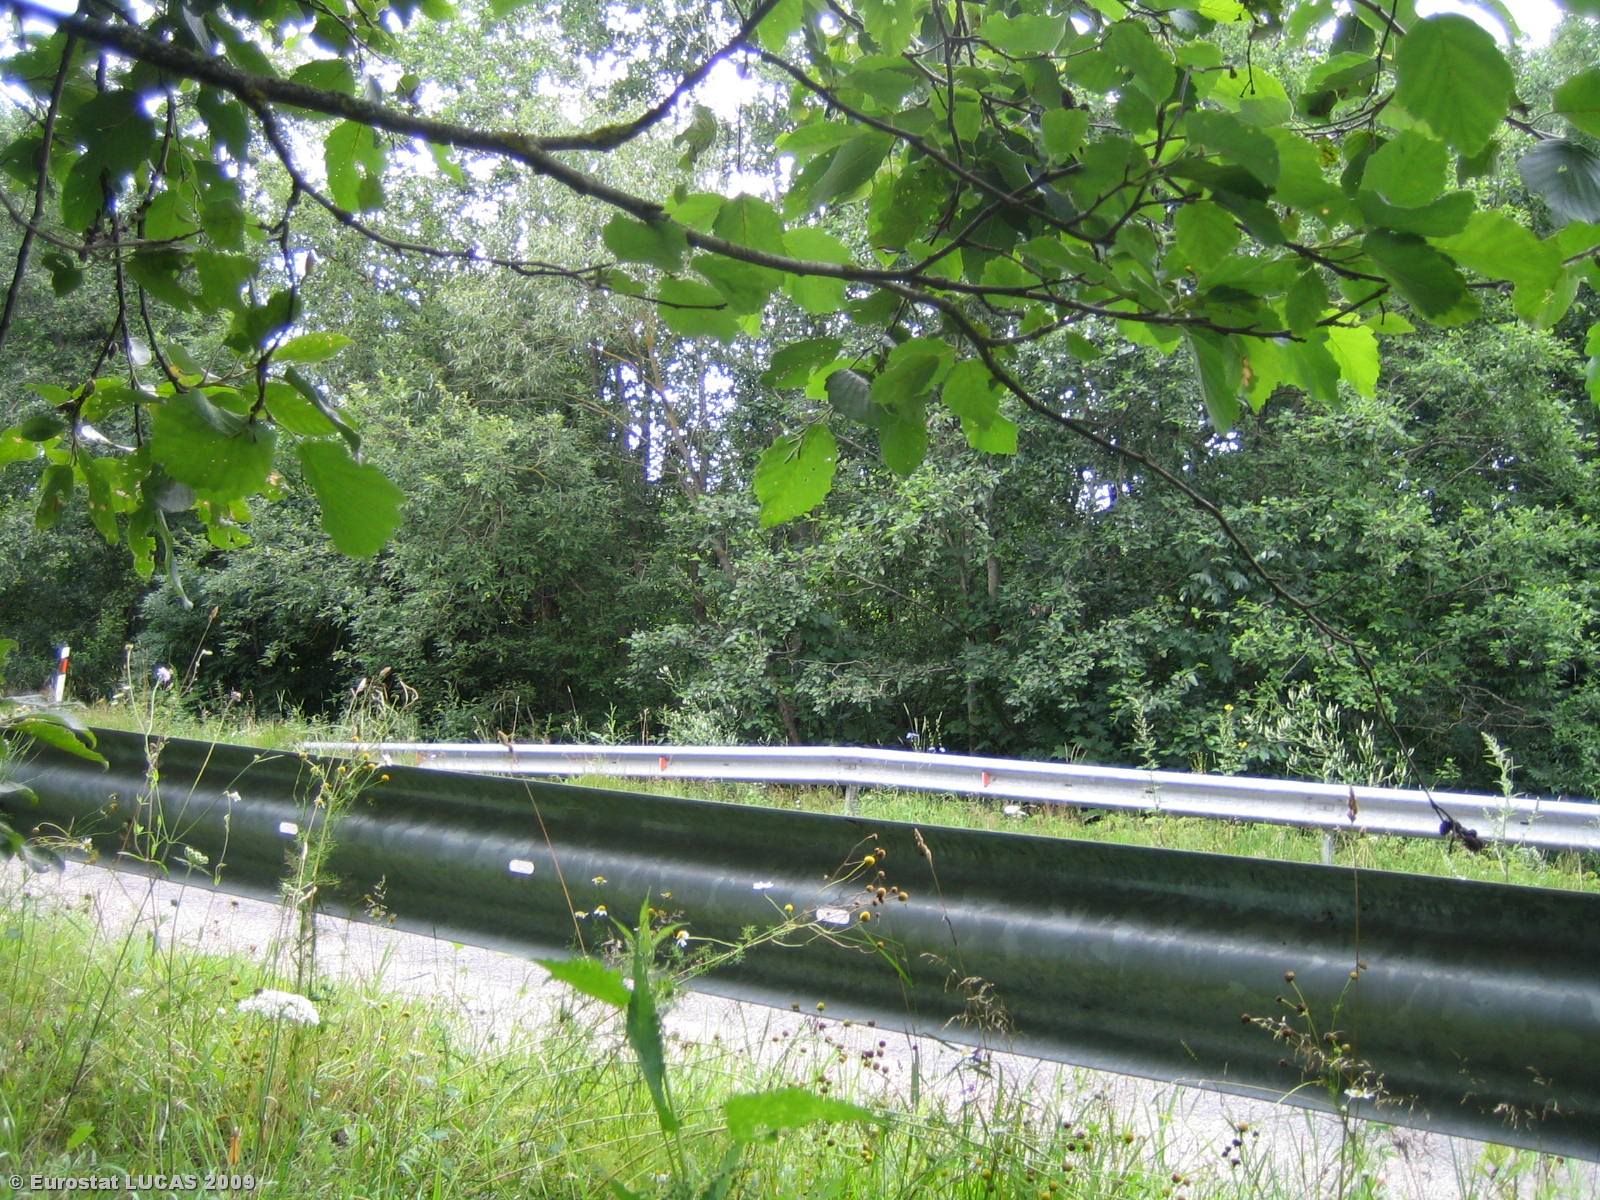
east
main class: Woodland
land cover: Broadleaved woodland
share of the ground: > 75 %
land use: Forestry
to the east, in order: Broadleaved woodland; Grass margins; Paved roads, cycling and walking lanes; Grass margins; Broadleaved woodland; Tracks; Grassland without tree/shrub cover; Artificial constructions in urban areas; Broadleaved woodland
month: July
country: LT
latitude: 55.4562
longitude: 25.5110
